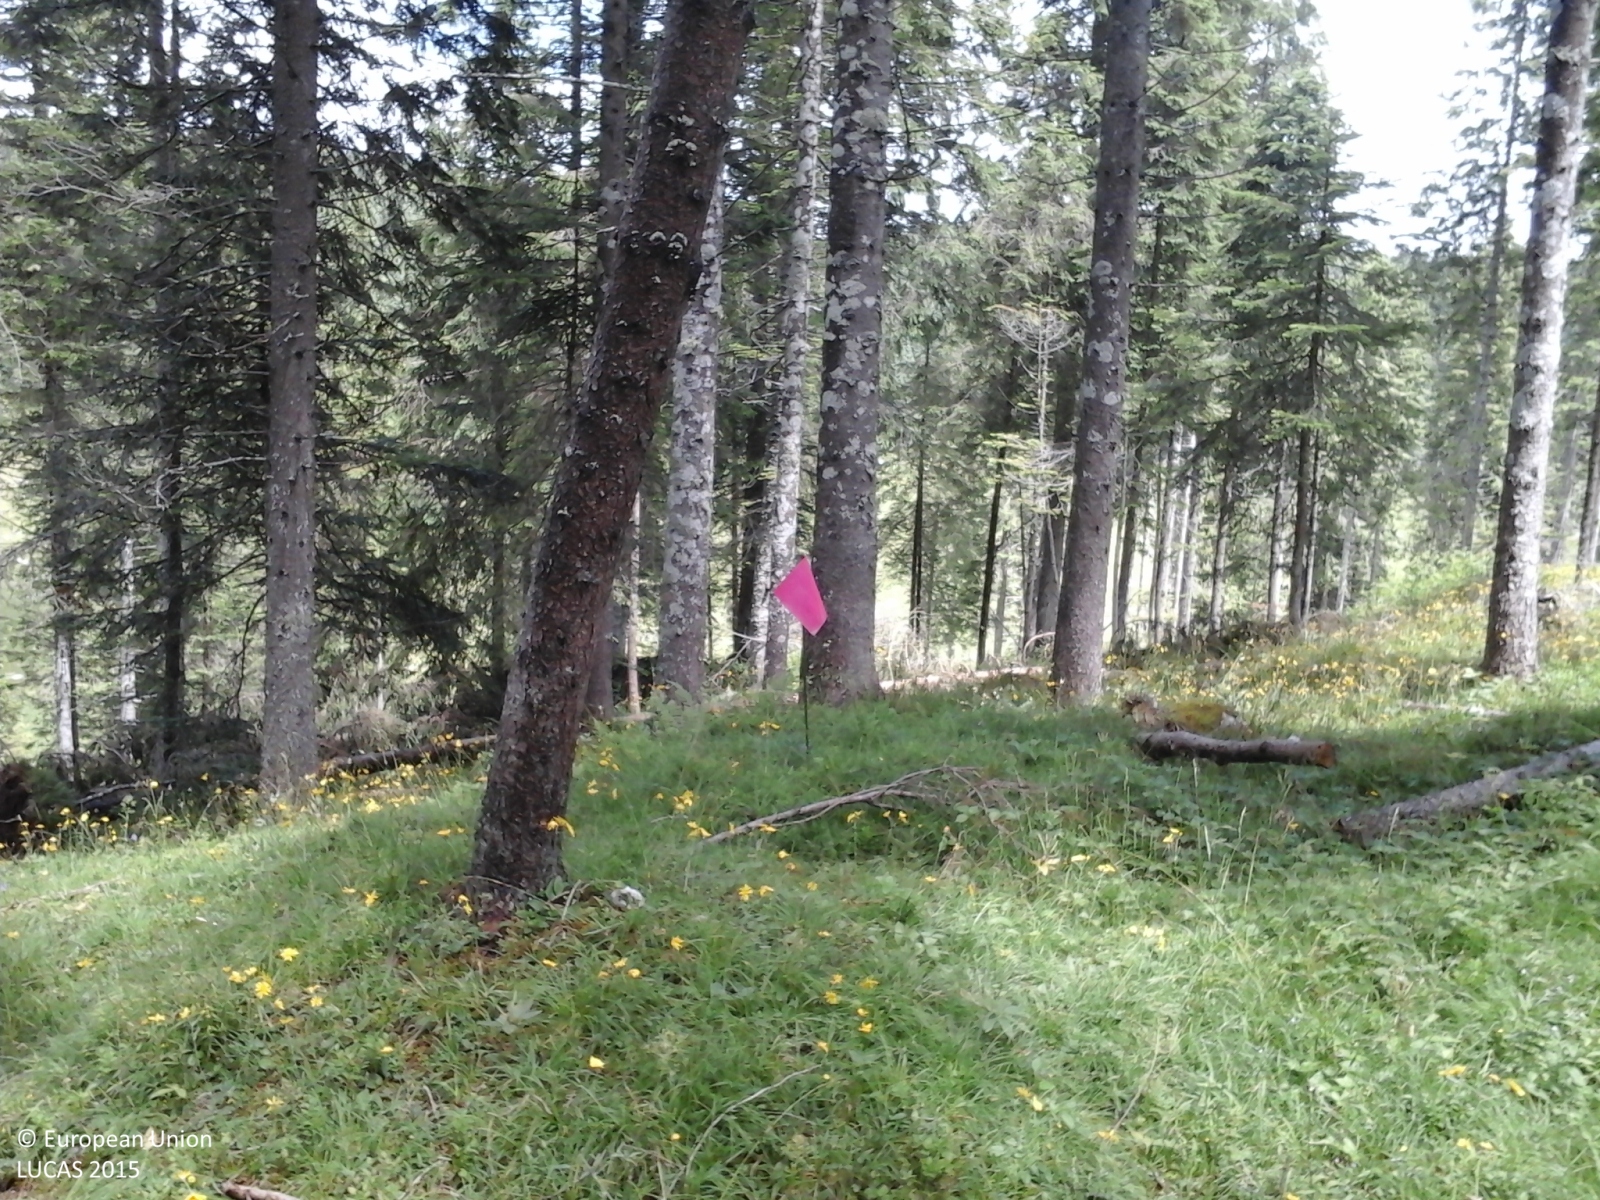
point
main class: Woodland
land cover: Spruce dominated coniferous woodland
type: alpine coniferous forest
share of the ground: > 75 %
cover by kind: coniferous forest trees 100 %
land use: Forestry
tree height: > 5 m
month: June
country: IT
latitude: 45.9431
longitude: 11.5843
